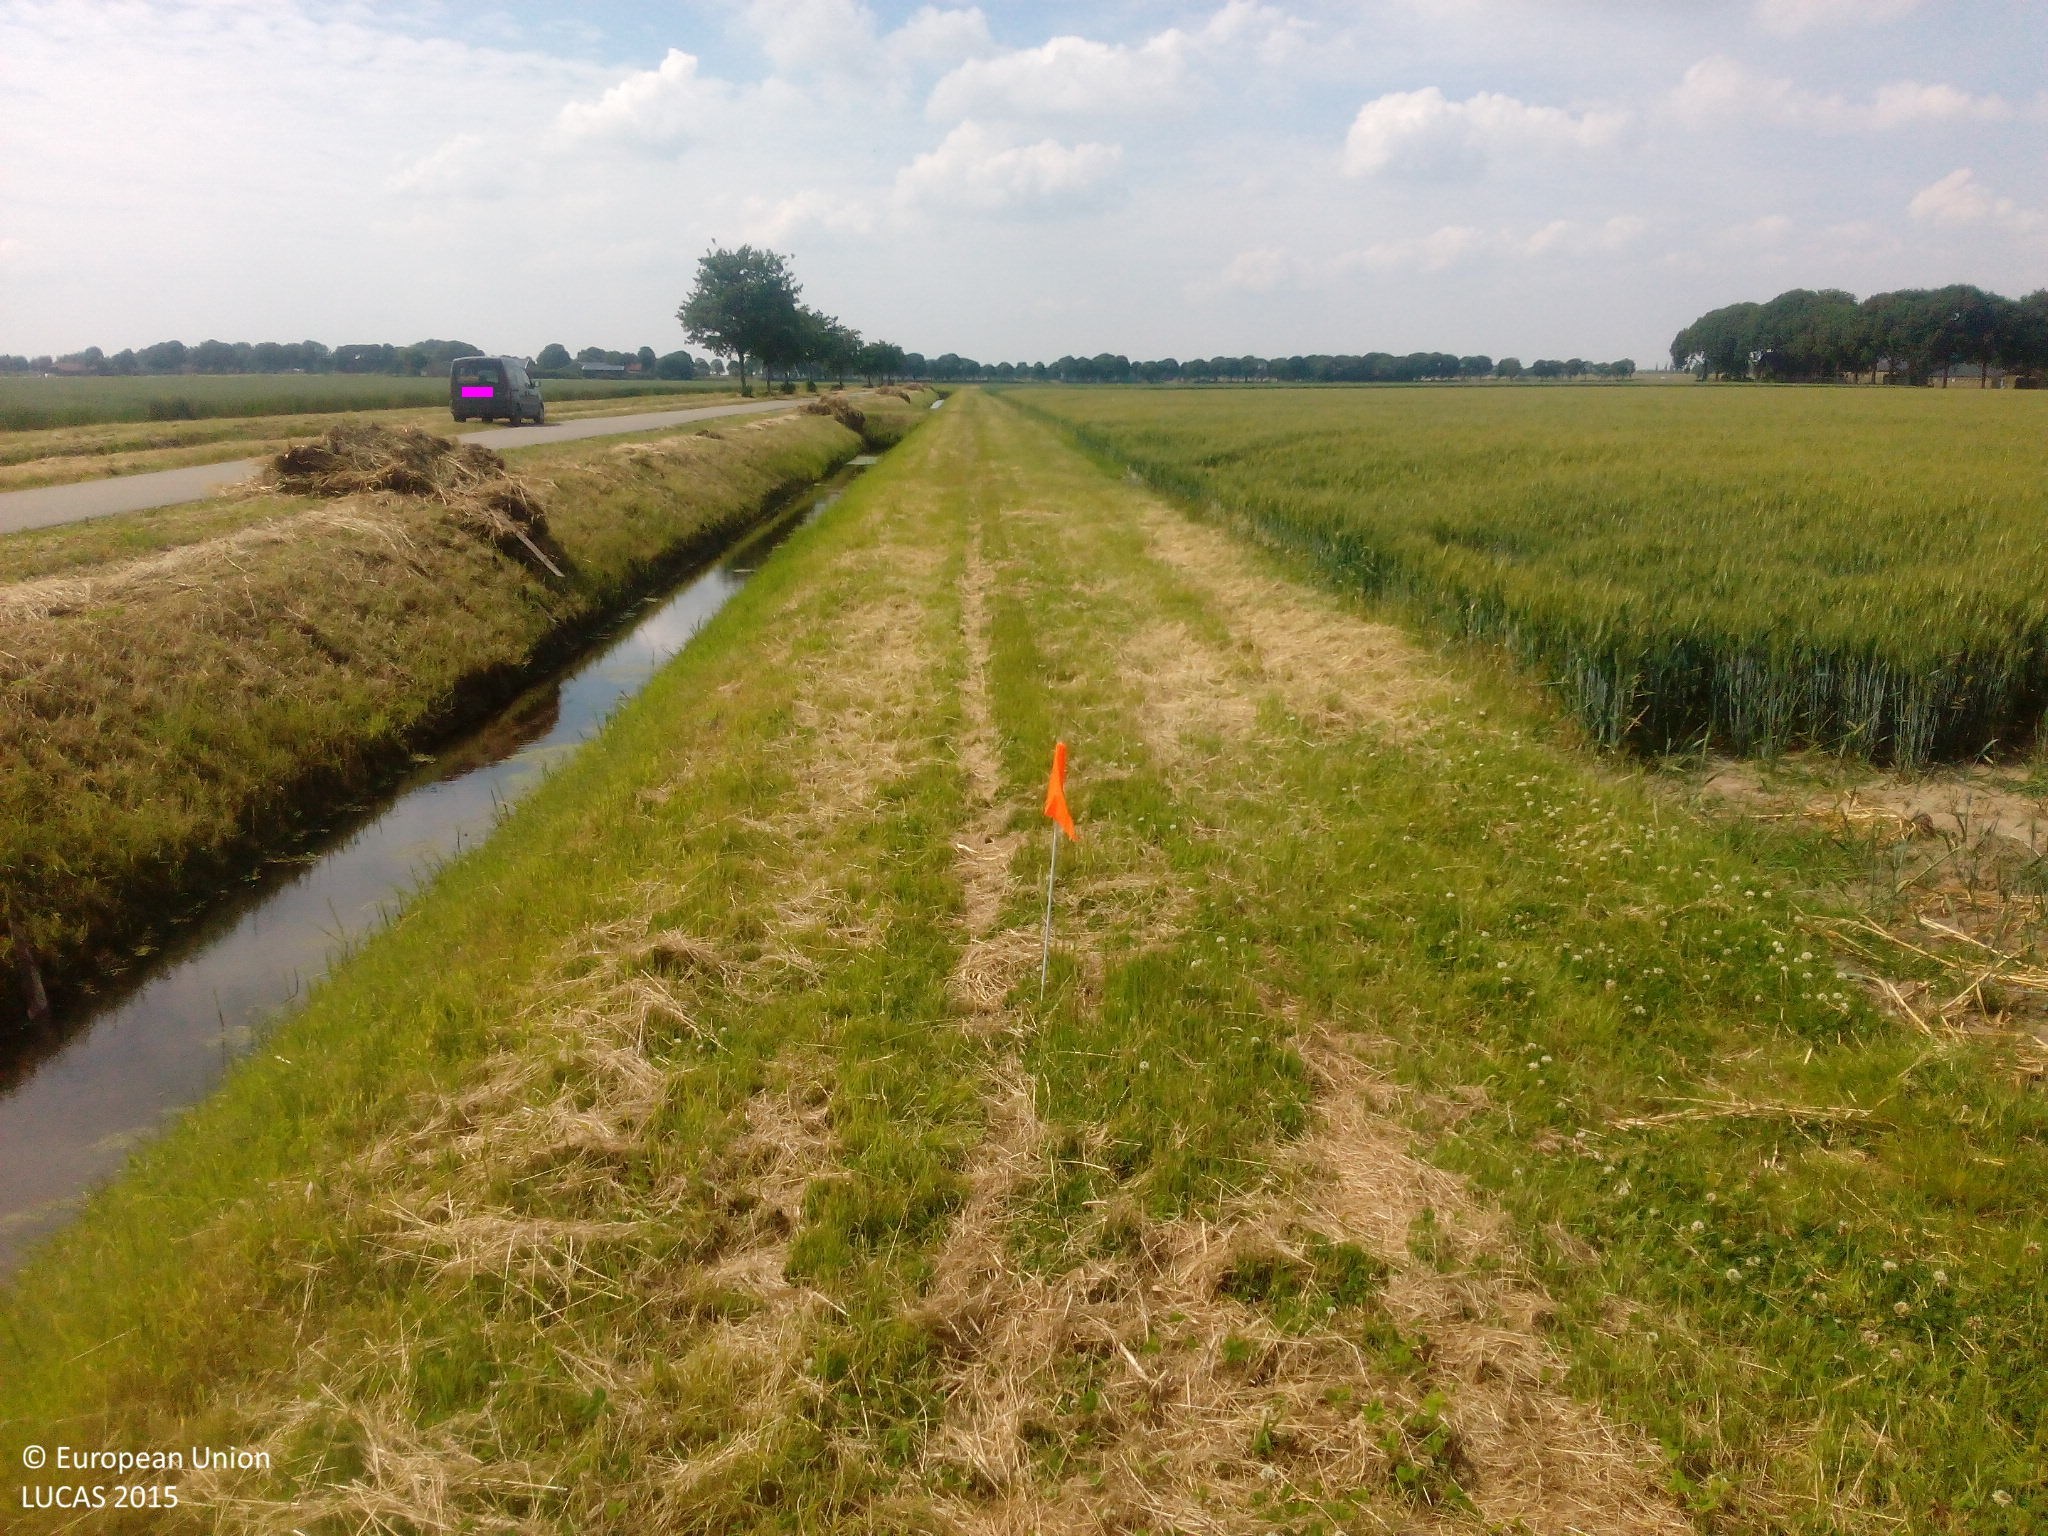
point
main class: Grassland
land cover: Grassland without tree/shrub cover
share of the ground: > 75 %
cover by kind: herbaceous plants 90 %, consolidated bare surface 10 %
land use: Agriculture (excluding fallow land and kitchen gardens)
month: June
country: NL
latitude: 51.7001
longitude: 4.6862
